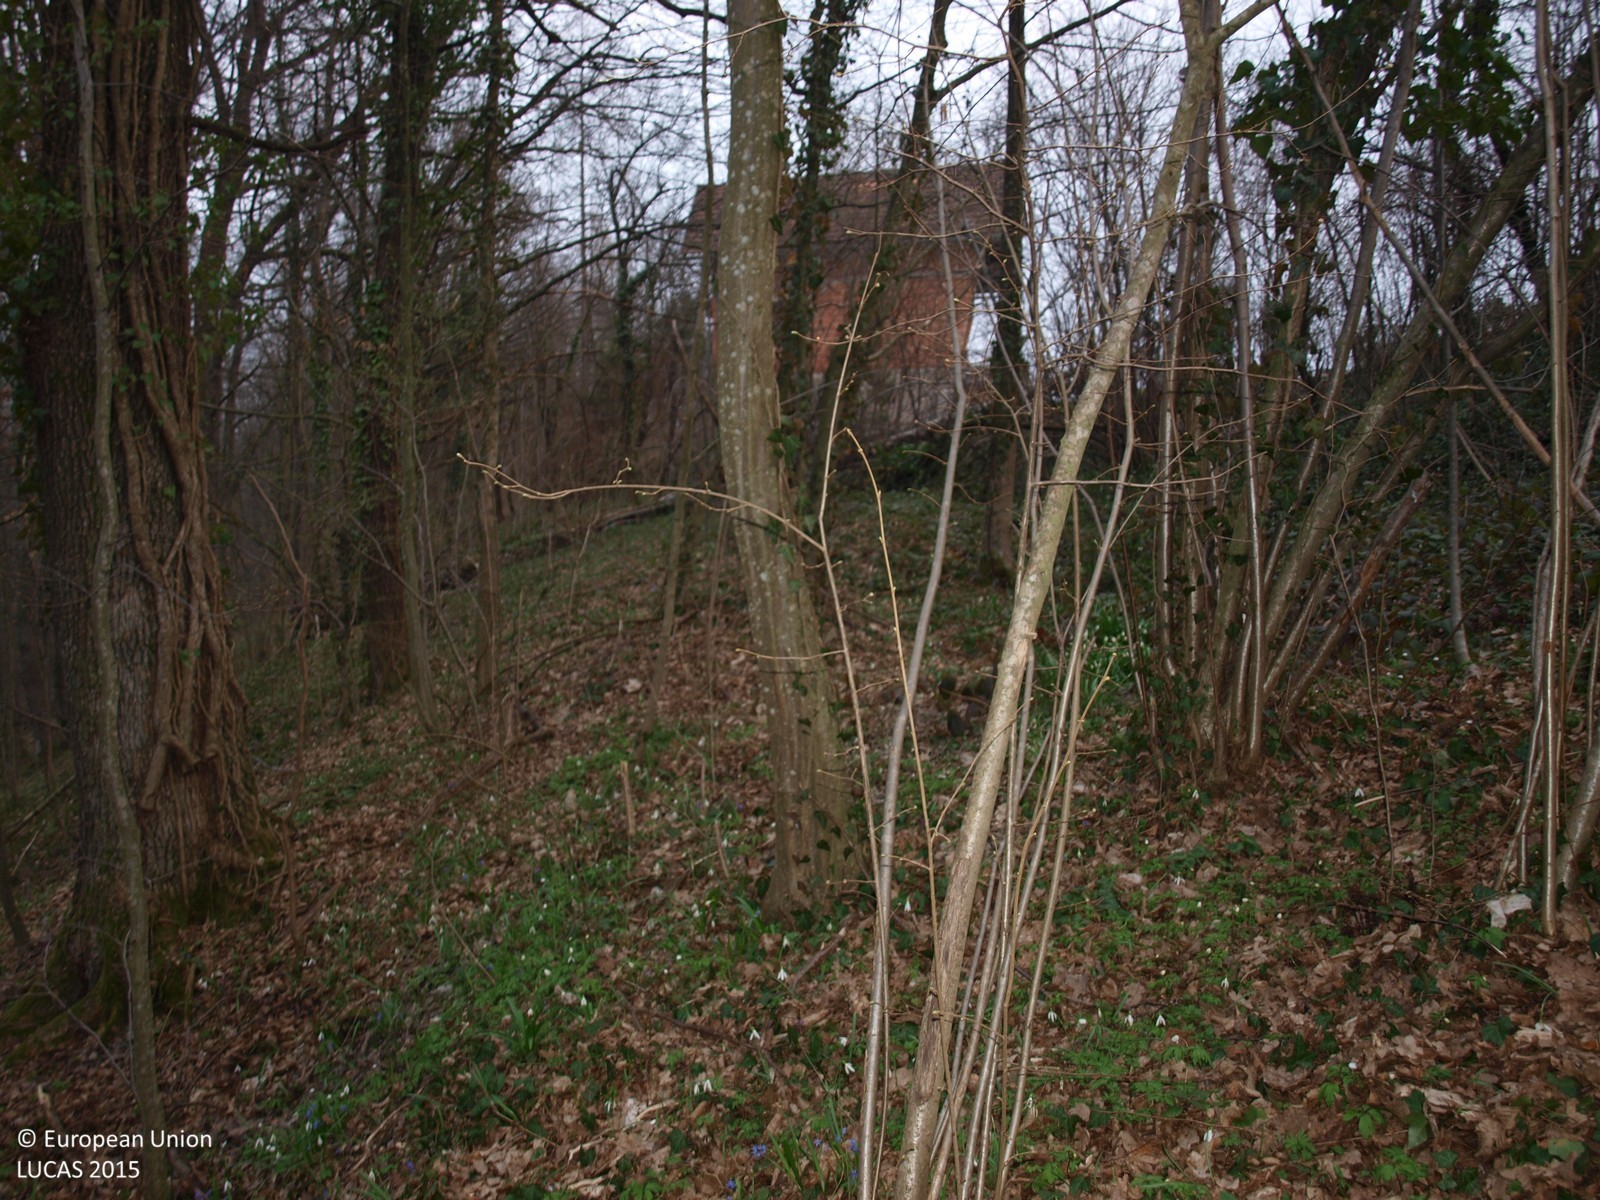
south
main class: Woodland
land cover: Broadleaved woodland
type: mesophytic deciduous forest
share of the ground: > 75 %
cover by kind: broadleaved forest trees 100 %
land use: Forestry
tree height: > 5 m
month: March
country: HR
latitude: 46.2203
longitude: 15.9754
